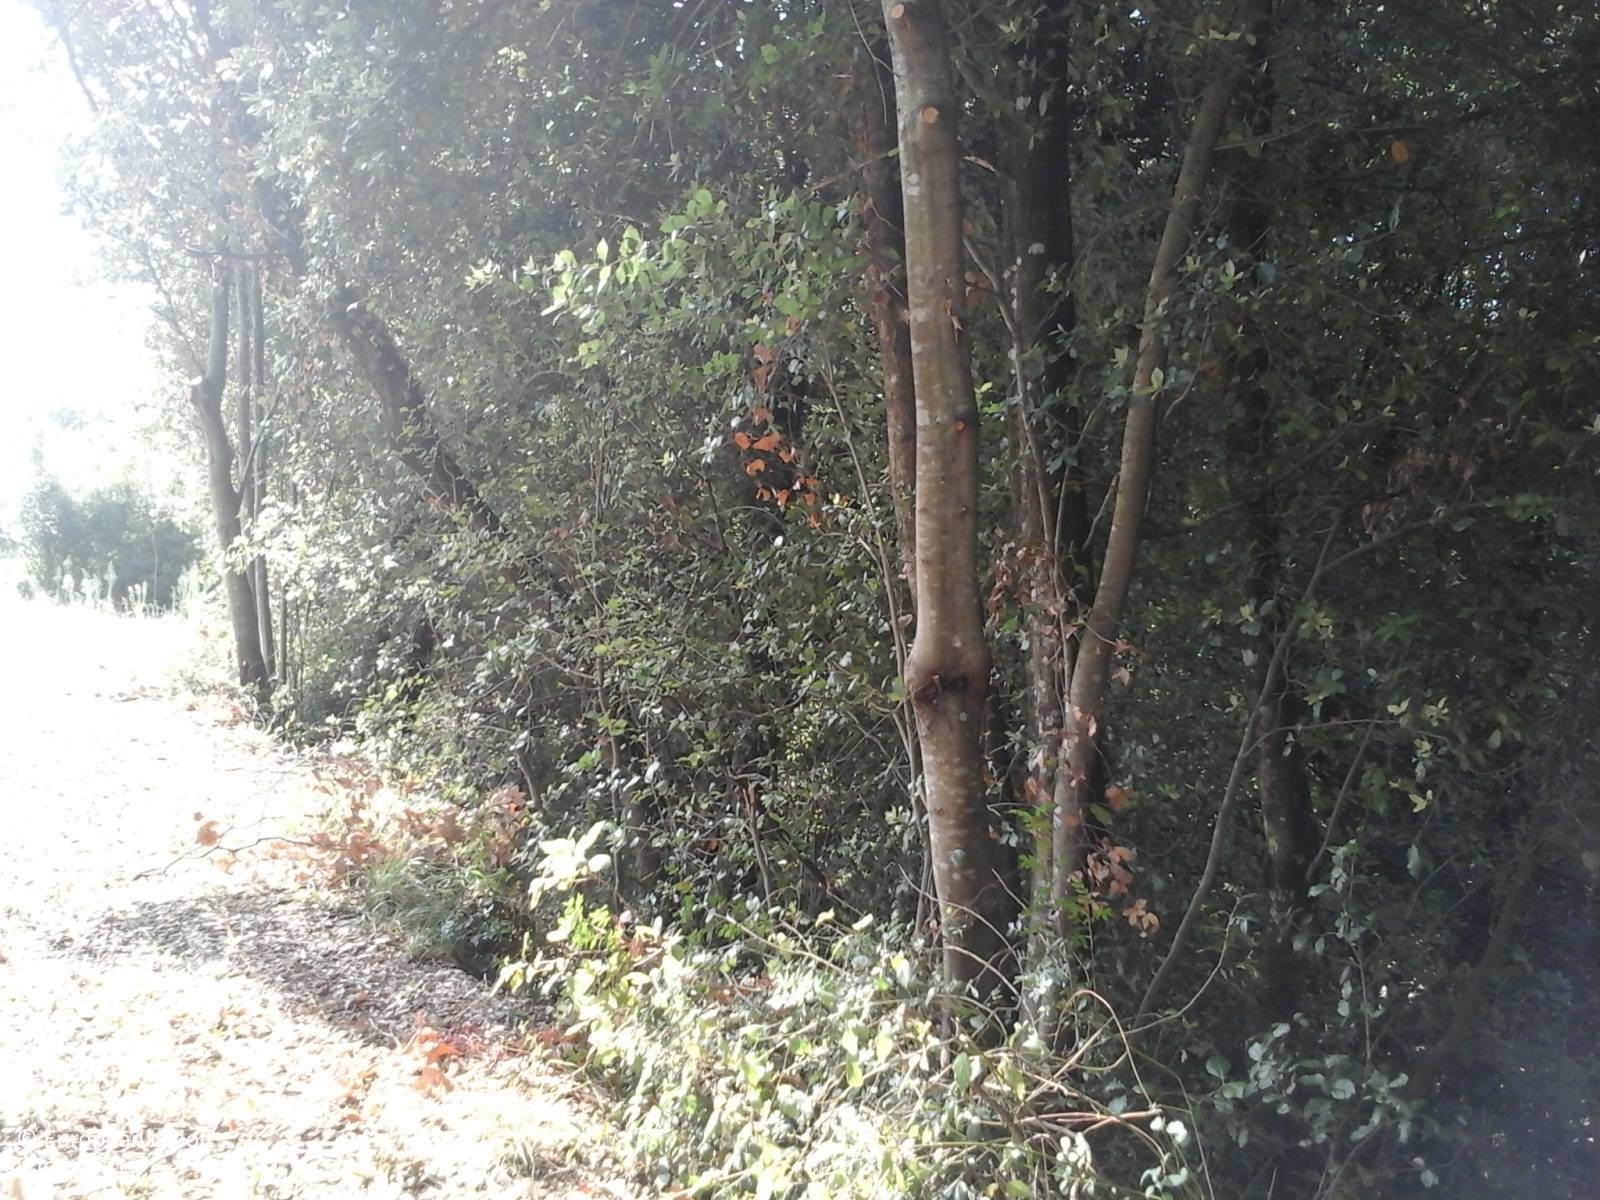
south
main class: Grassland
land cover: Grassland without tree/shrub cover
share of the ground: > 75 %
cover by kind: herbaceous plants 100 %
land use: Agriculture (excluding fallow land and kitchen gardens)
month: August
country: IT
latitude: 41.5378
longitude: 13.1641
